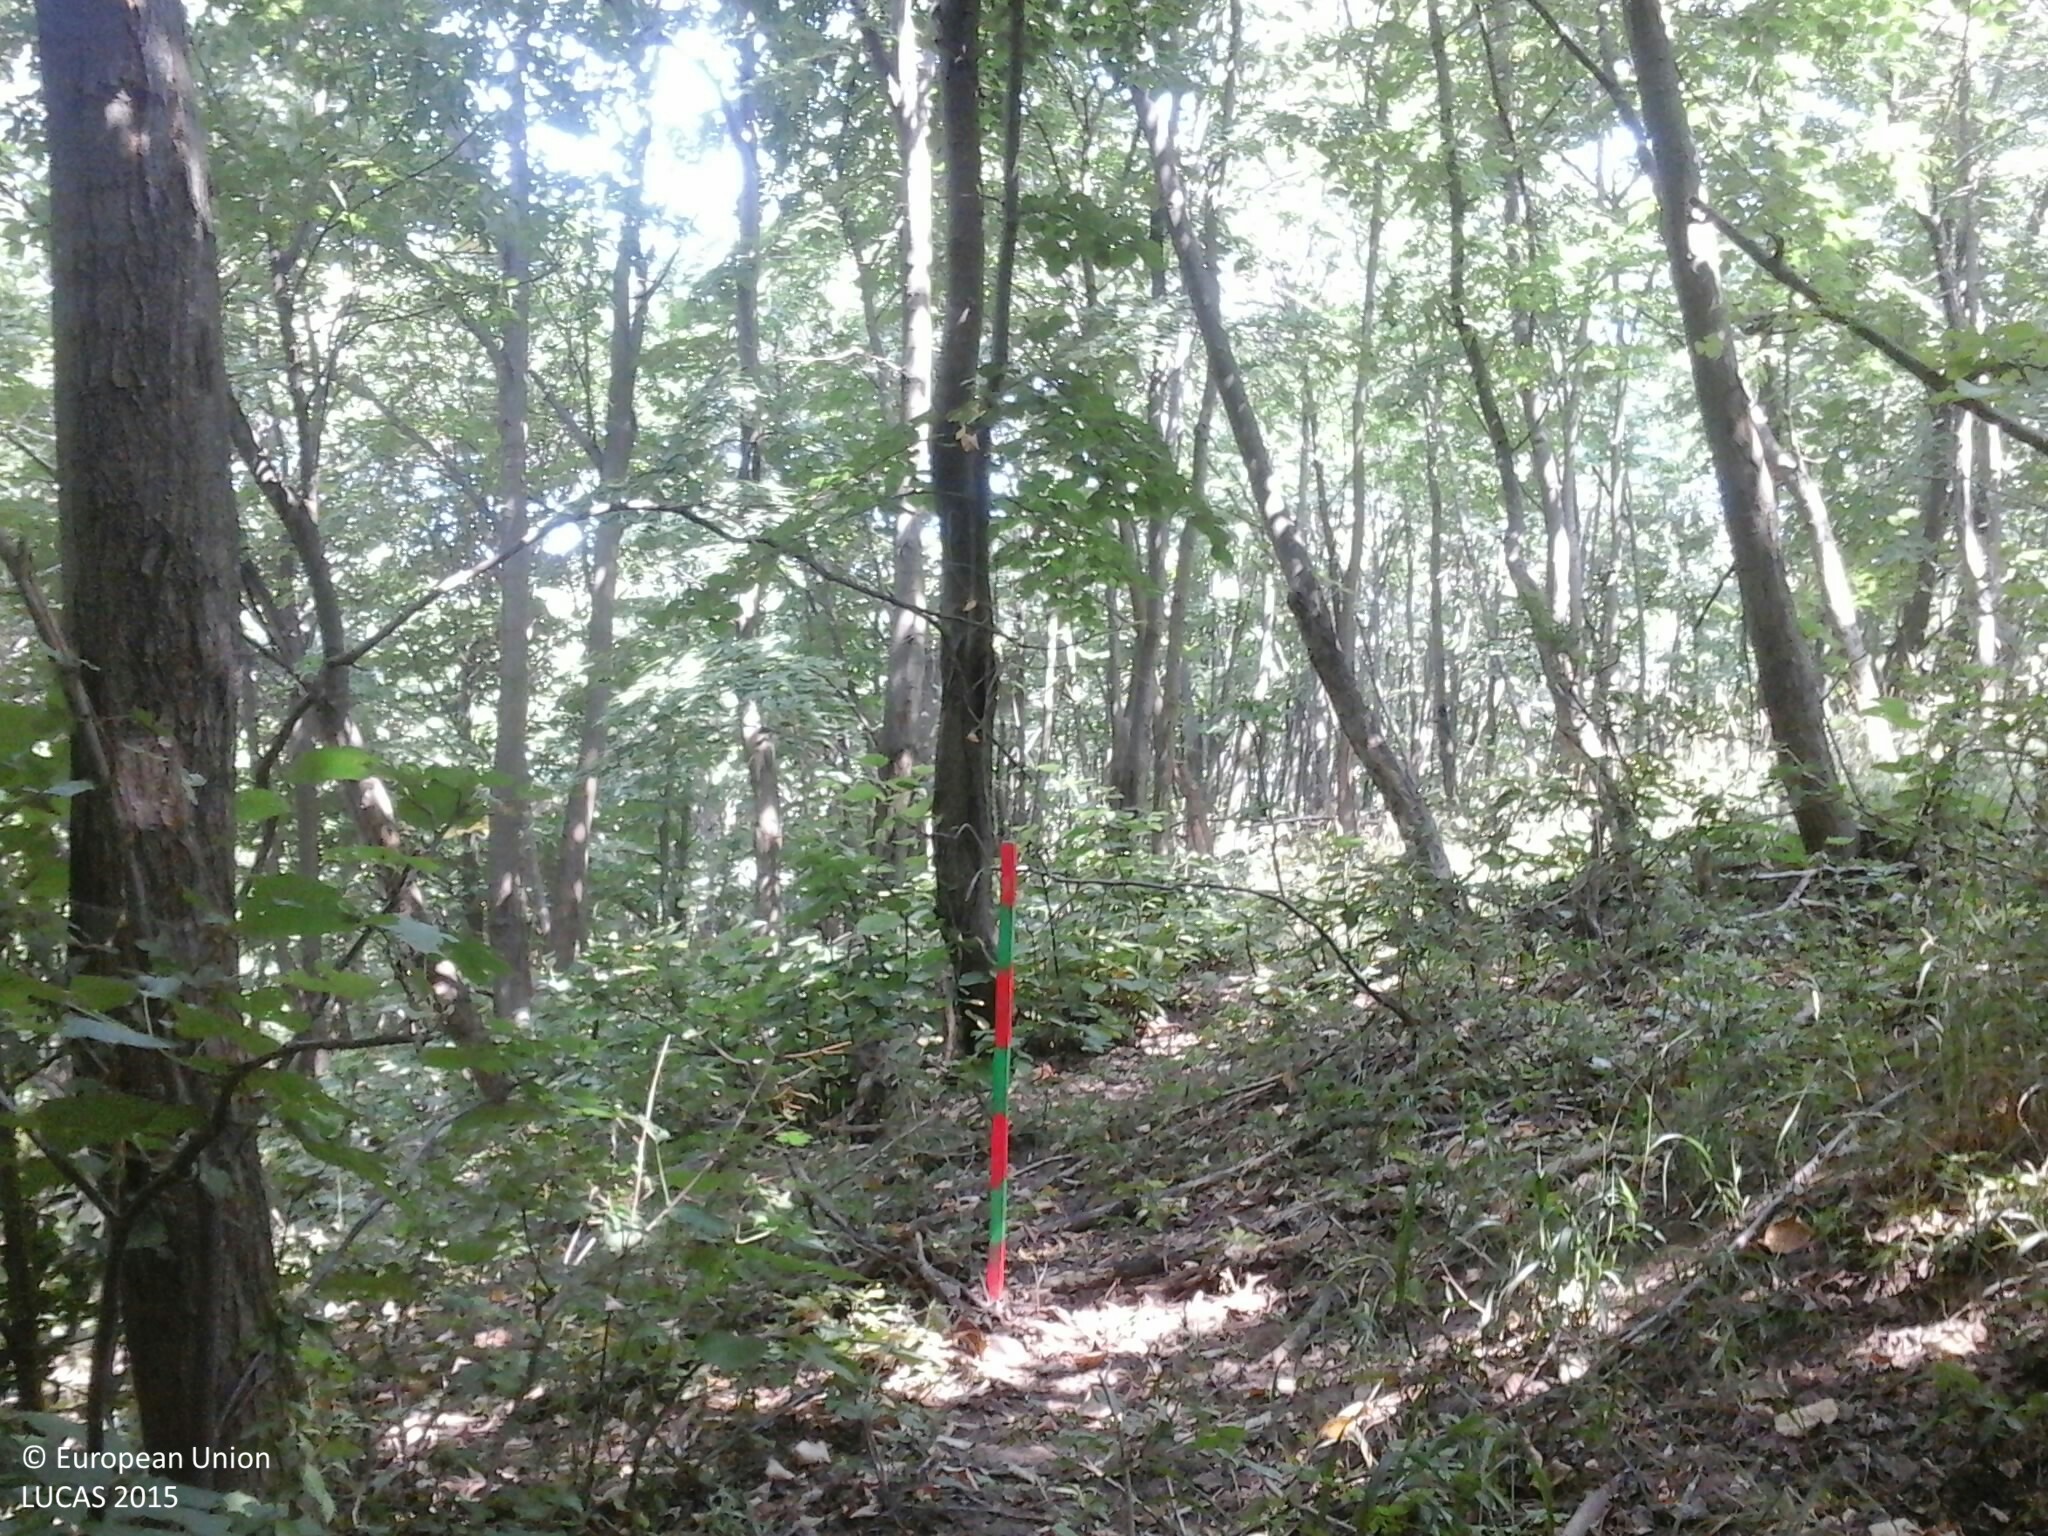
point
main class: Woodland
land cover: Broadleaved woodland
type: mesophytic deciduous forest
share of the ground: > 75 %
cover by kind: broadleaved forest trees 95 %, herbaceous plants 5 %
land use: Forestry
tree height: > 5 m
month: August
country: HU
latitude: 46.8337
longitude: 17.9401
